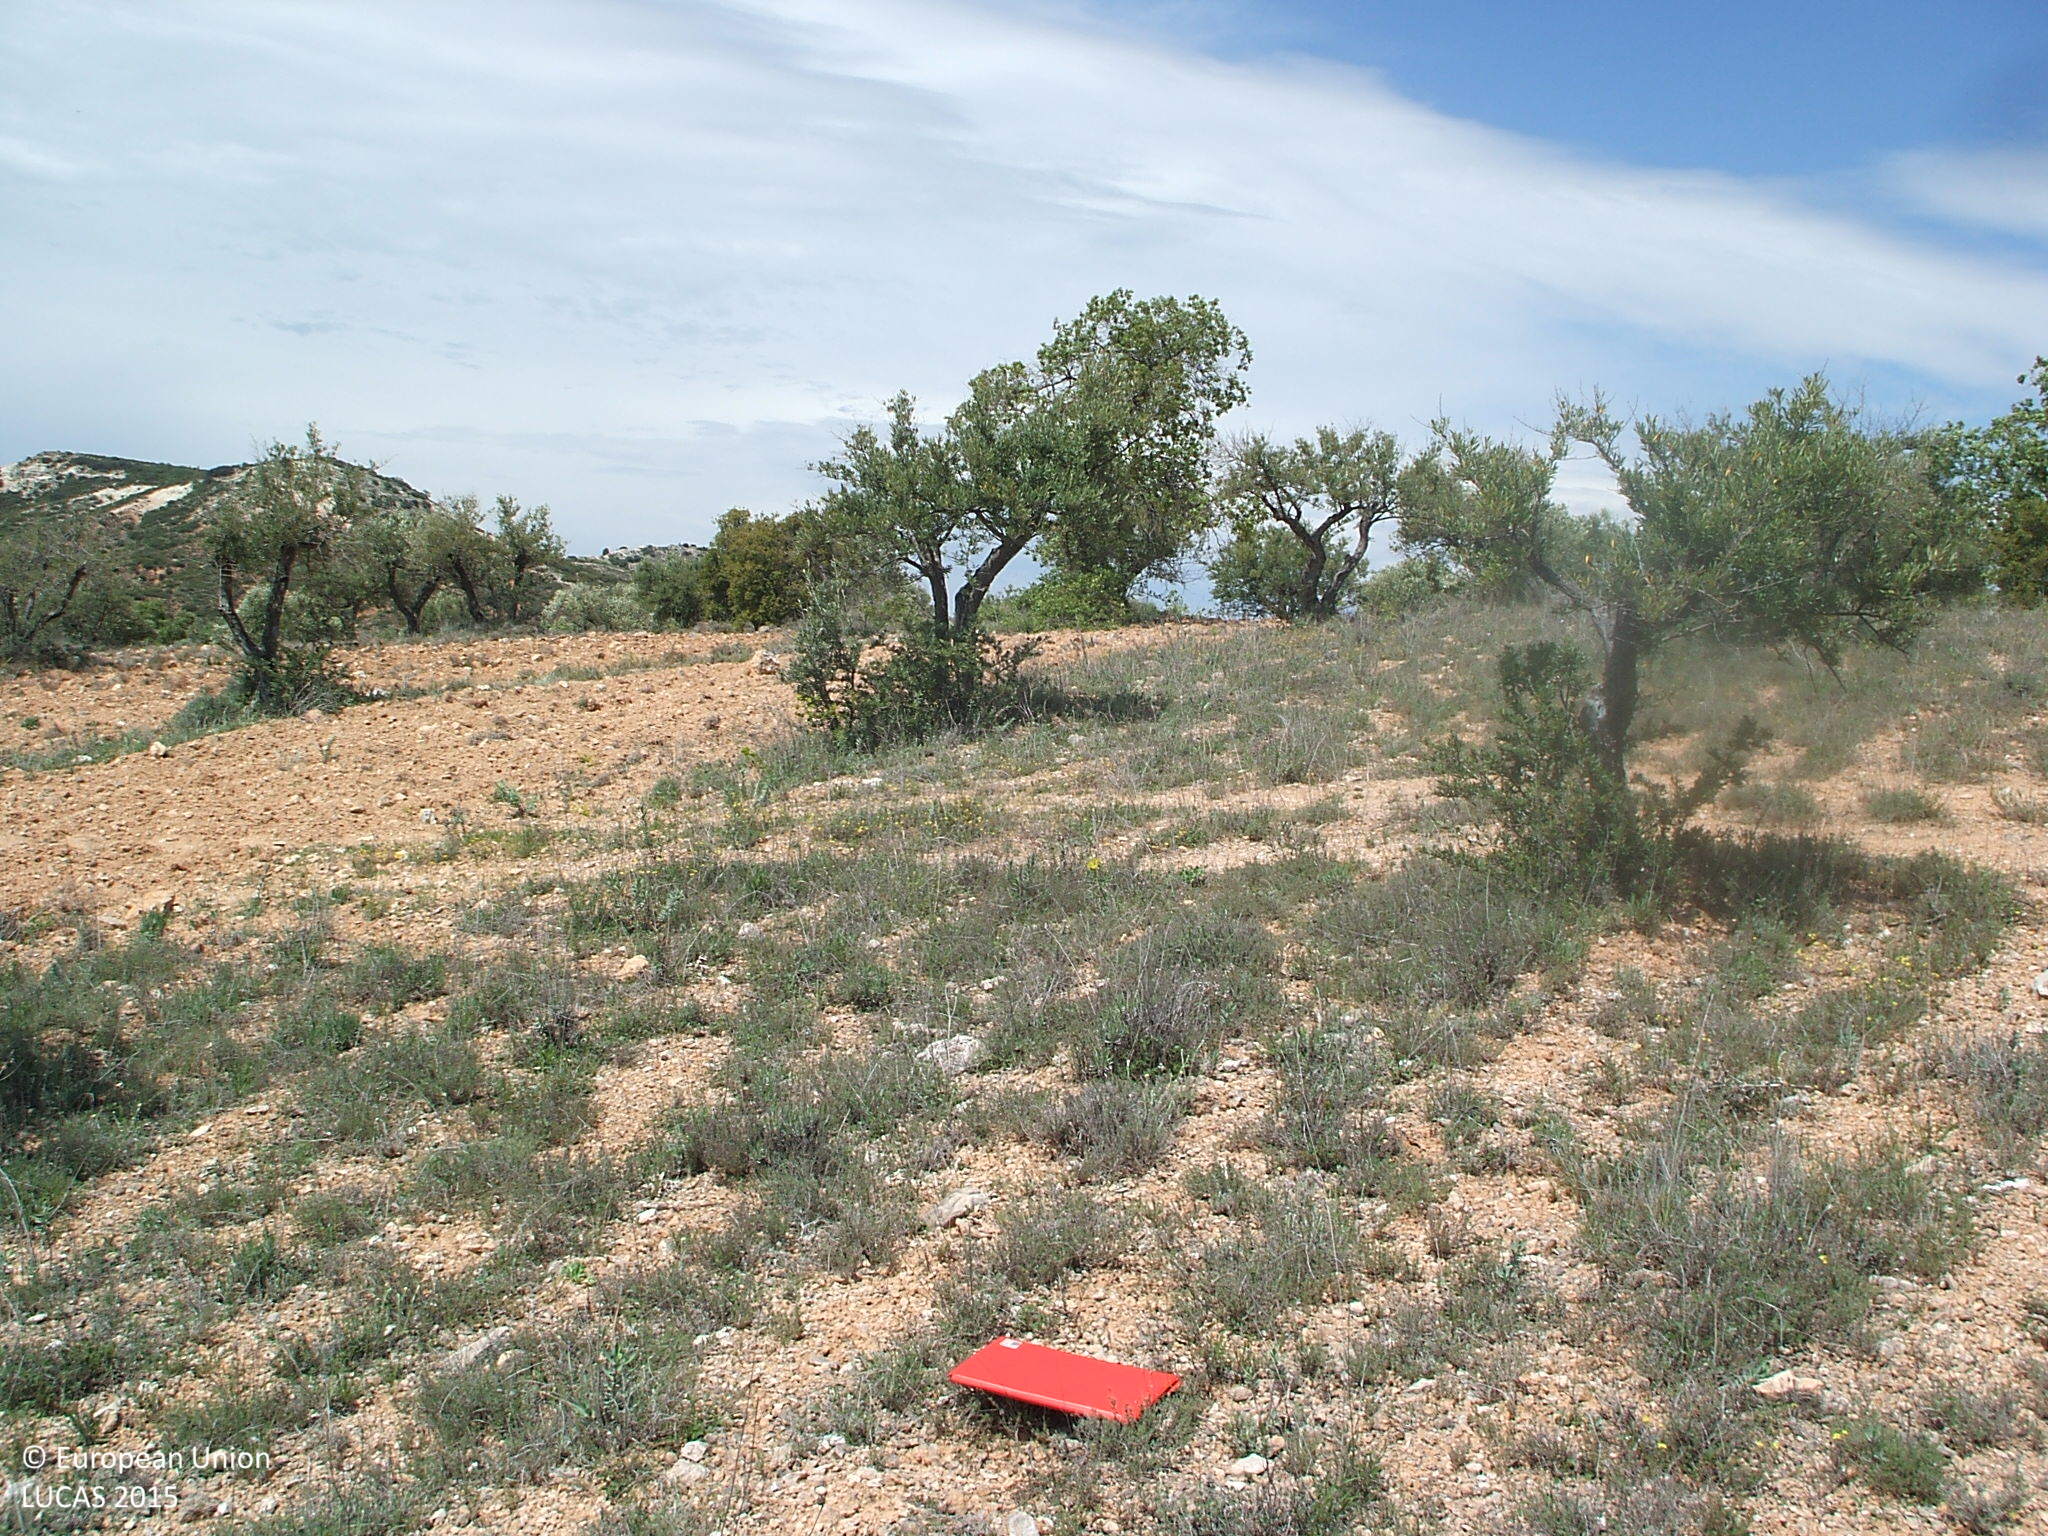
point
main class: Cropland
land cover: Olive groves
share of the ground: 25 - 50 %
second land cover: Grassland without tree/shrub cover
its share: 25 - 50 %
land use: Agriculture (excluding fallow land and kitchen gardens)
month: May
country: ES
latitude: 40.8439
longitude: -2.9975
